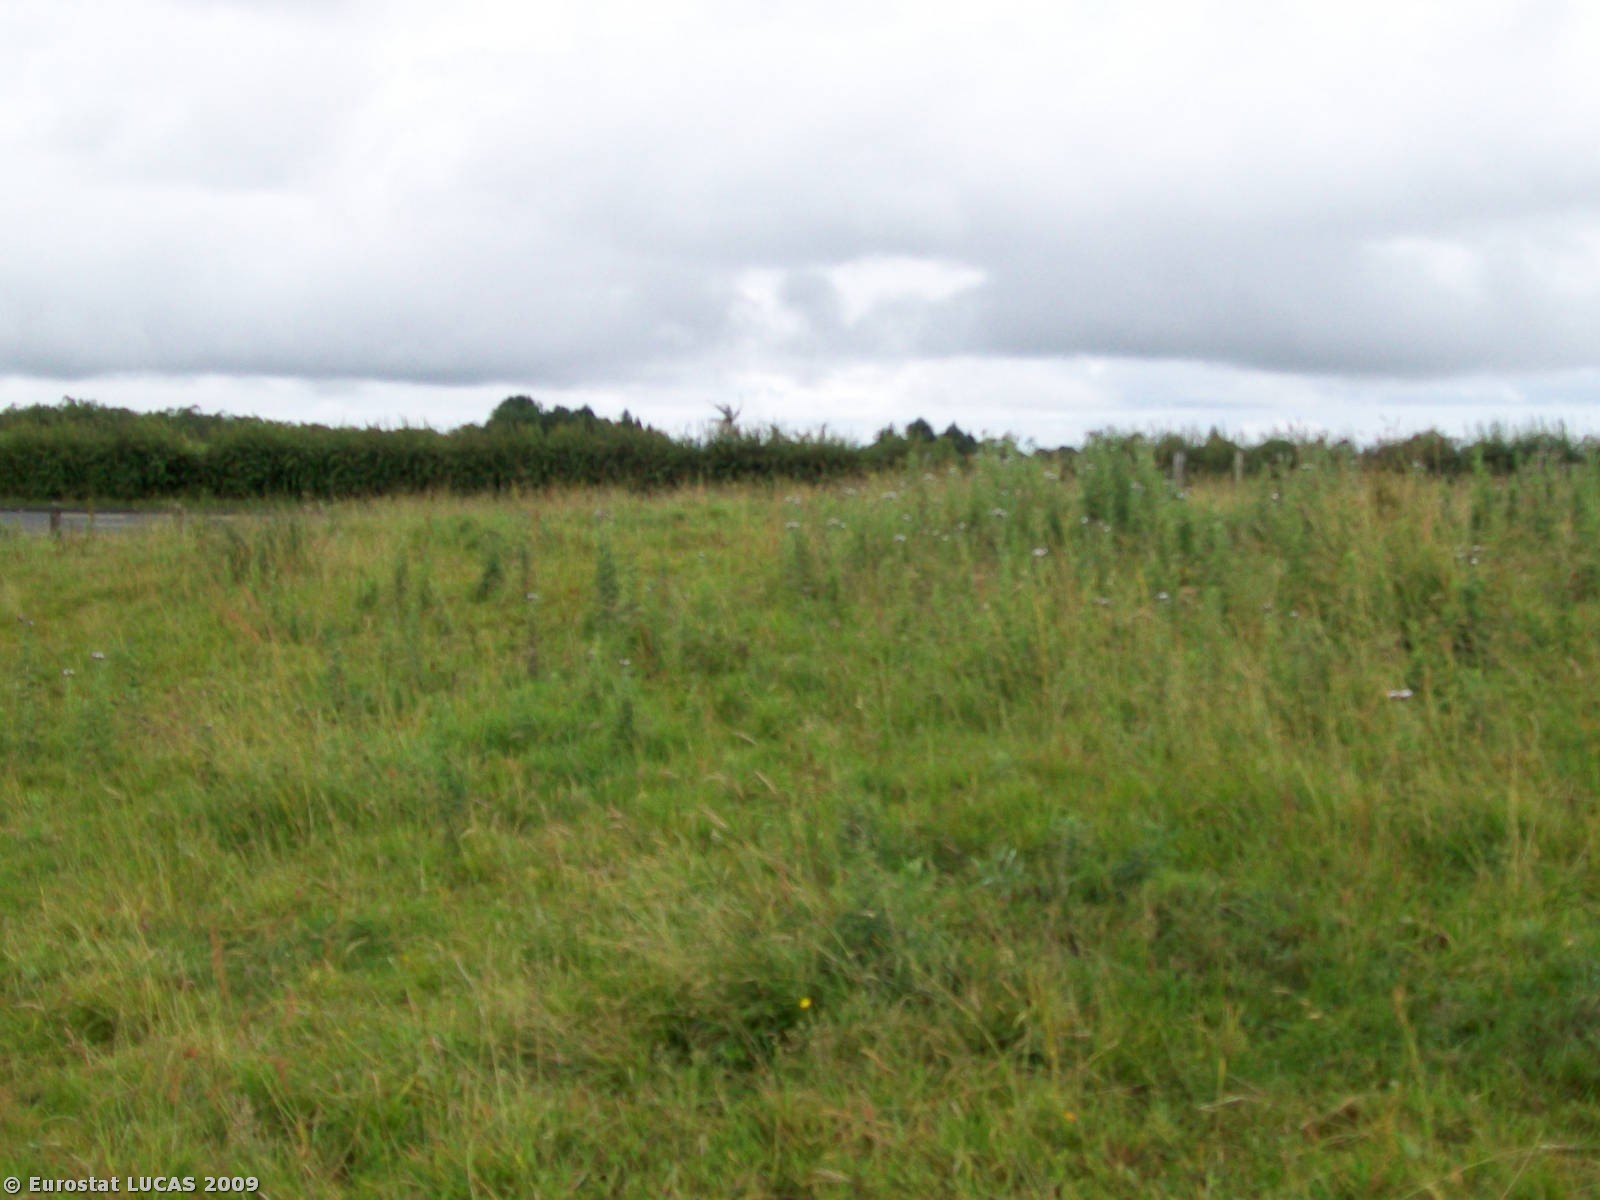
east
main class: Grassland
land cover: Grassland without tree/shrub cover
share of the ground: > 75 %
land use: Agriculture (excluding fallow land and kitchen gardens)
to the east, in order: Grassland without tree/shrub cover; Fences; Paved roads, cycling and walking lanes; Grass margins; Managed hedges; Fences; Grassland without tree/shrub cover
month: July
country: IE
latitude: 53.6945
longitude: -8.9757
